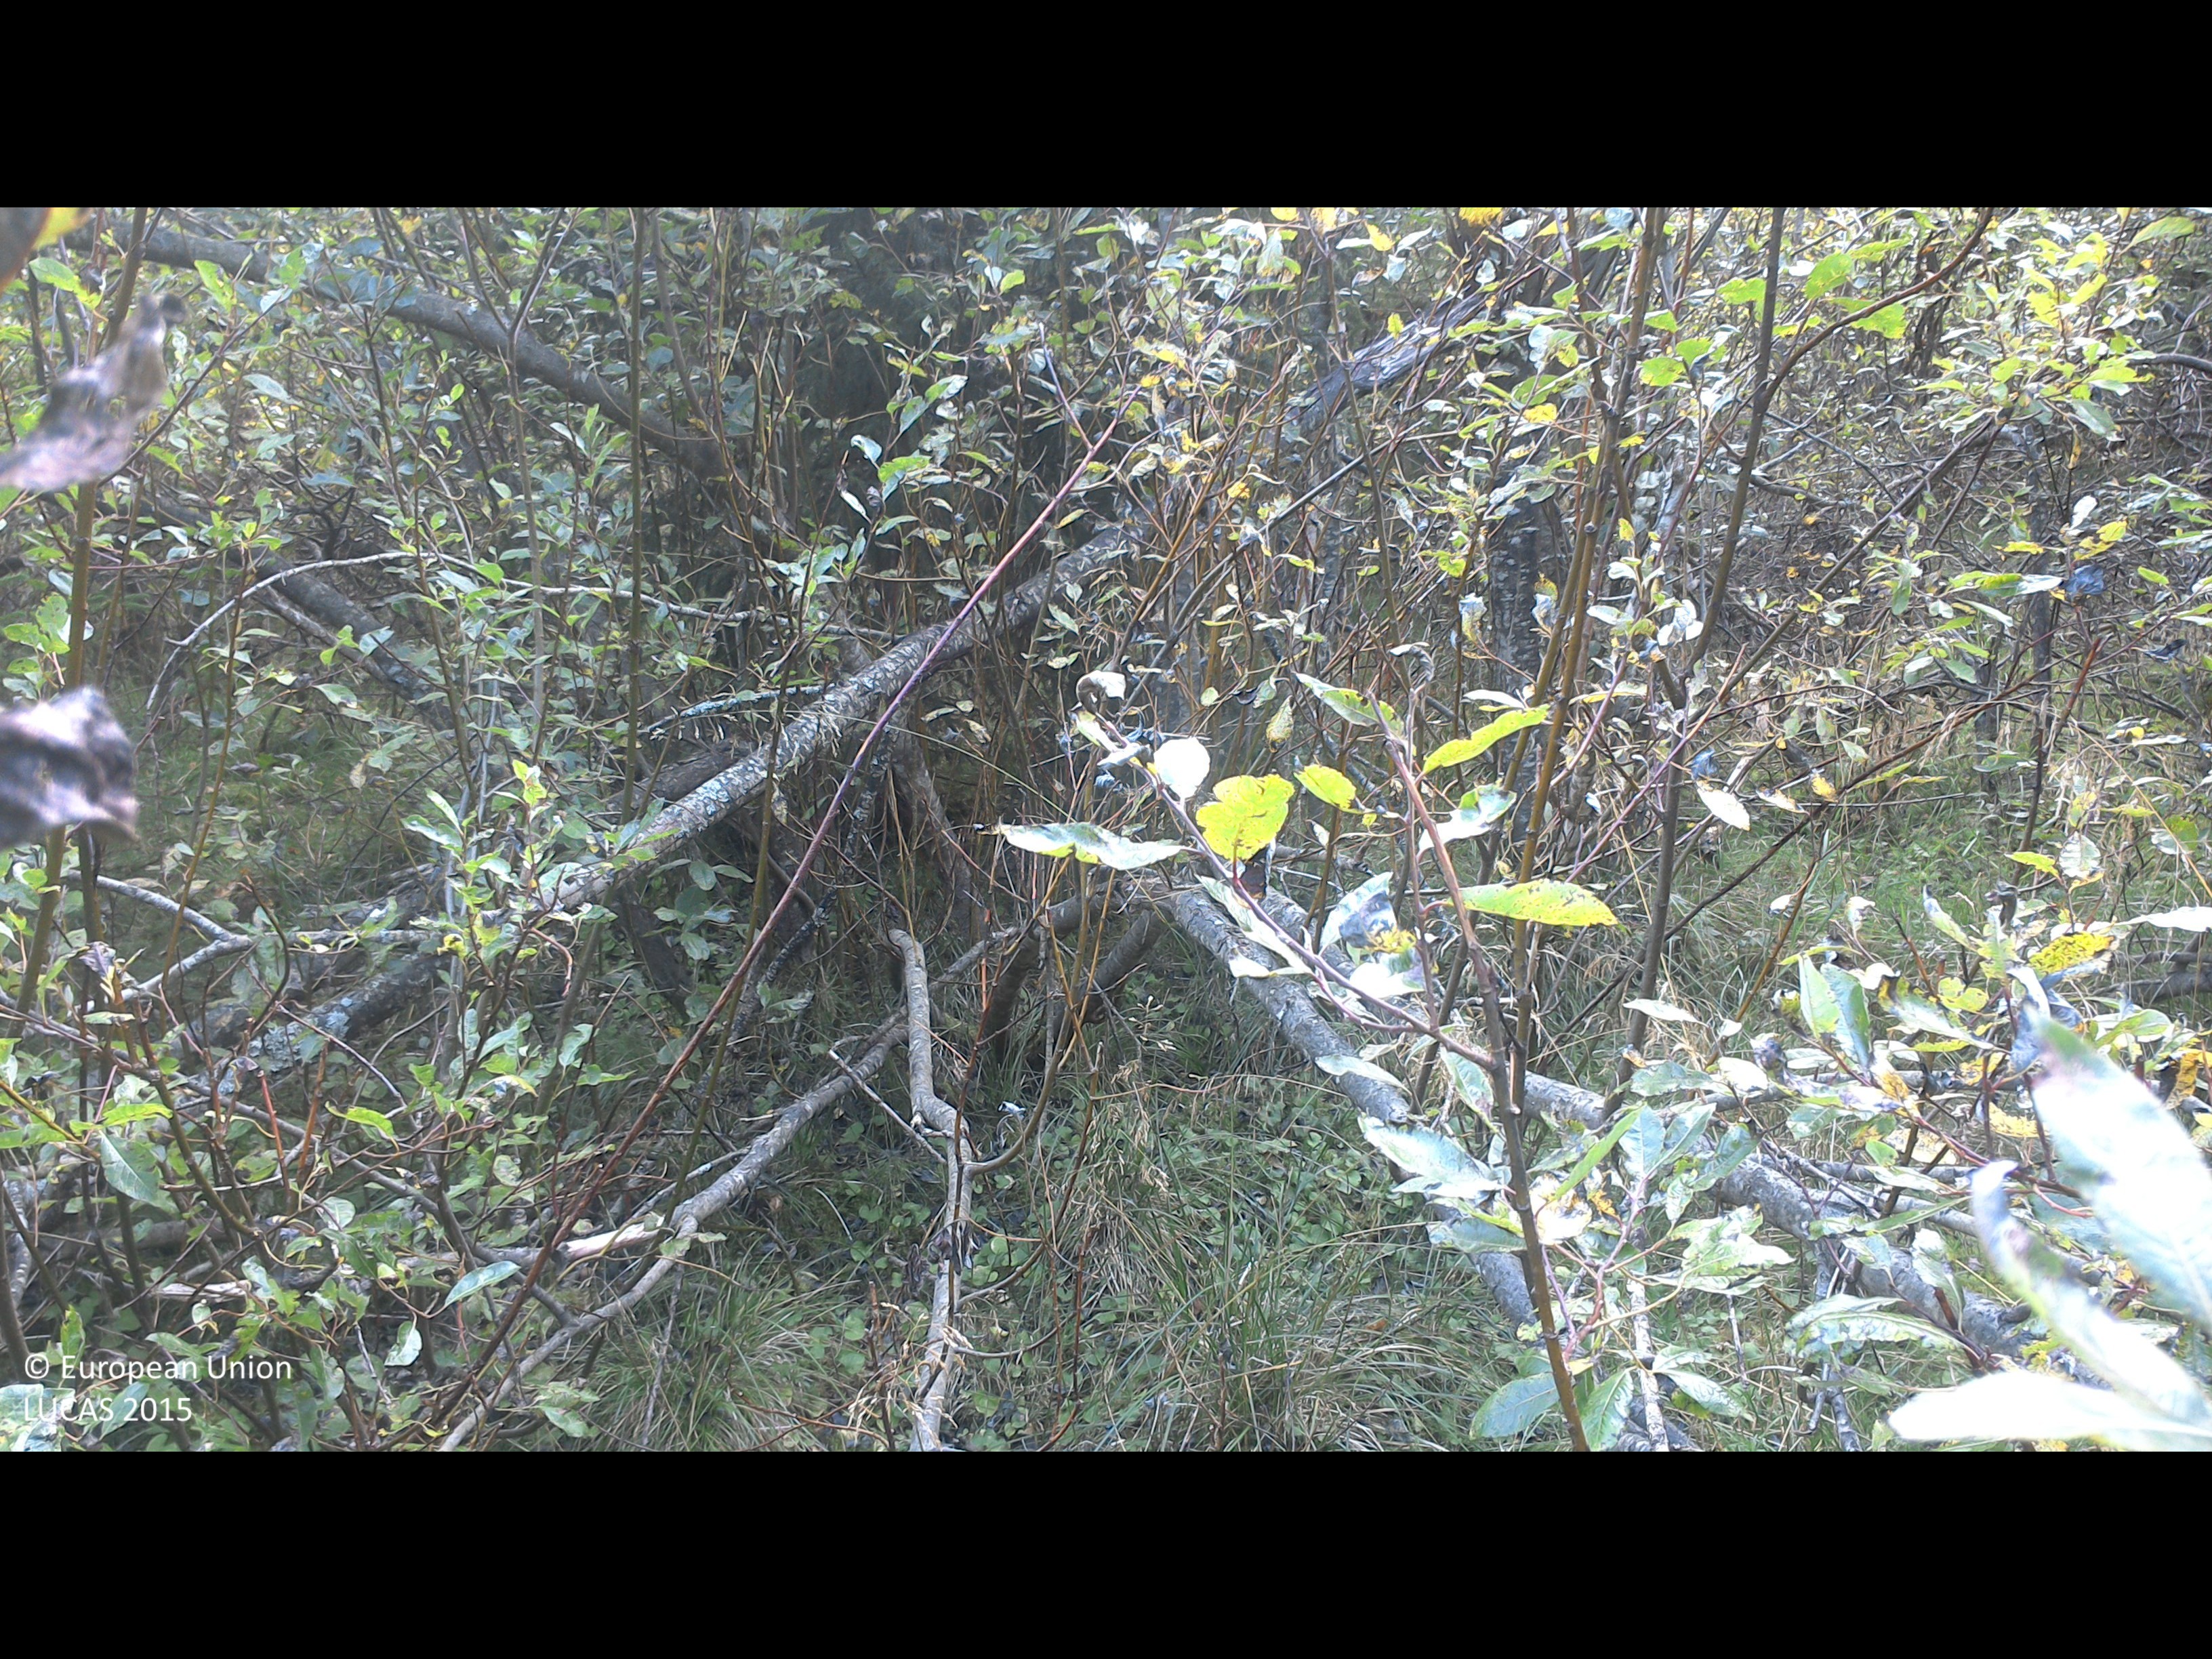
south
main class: Woodland
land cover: Broadleaved woodland
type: boreal forest
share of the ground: 50 - 75 %
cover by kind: broadleaved forest trees 60 %, herbaceous plants 40 %
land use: Semi-natural and natural areas not in use
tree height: > 5 m
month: September
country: SE
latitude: 63.8034
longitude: 19.4999
